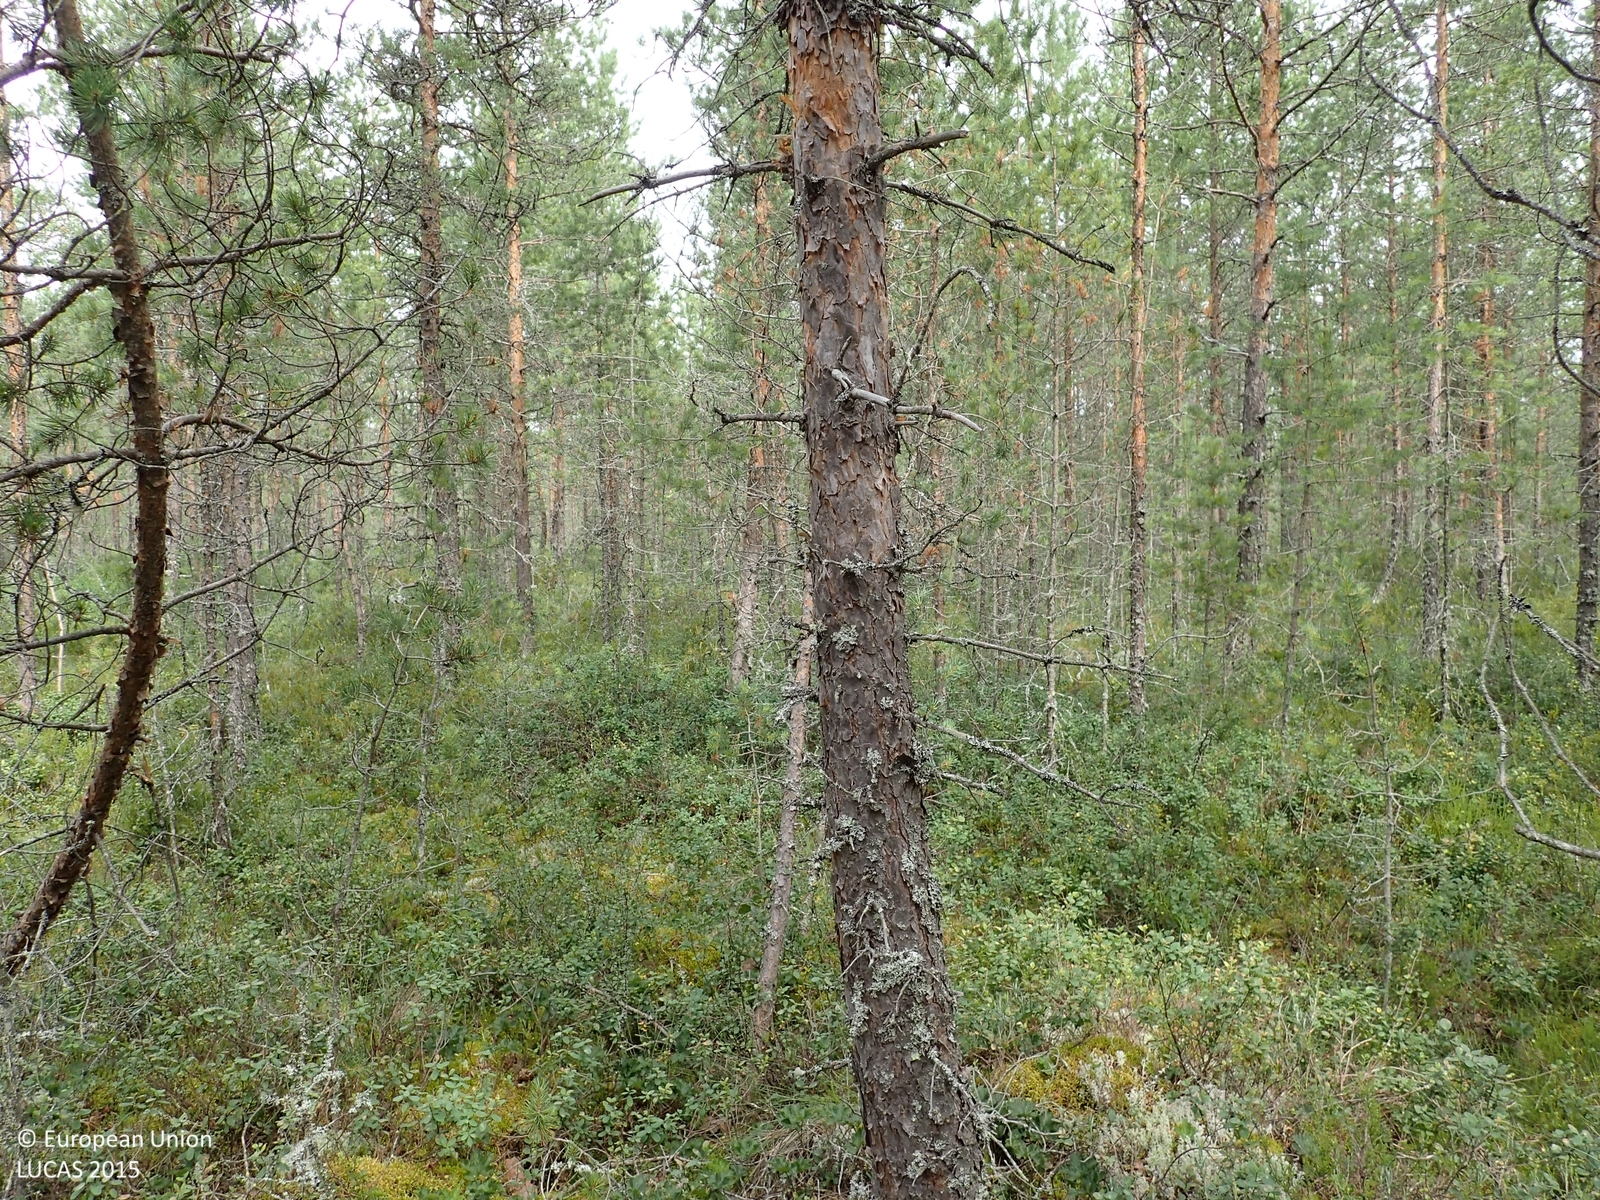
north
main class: Woodland
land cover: Pine dominated coniferous woodland
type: mire and swamp forests
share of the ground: 50 - 75 %
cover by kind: coniferous forest trees 60 %, shrubs 25 %, lichens and mosses 15 %
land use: Forestry
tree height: < 5 m
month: July
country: FI
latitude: 62.8086
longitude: 22.4296
